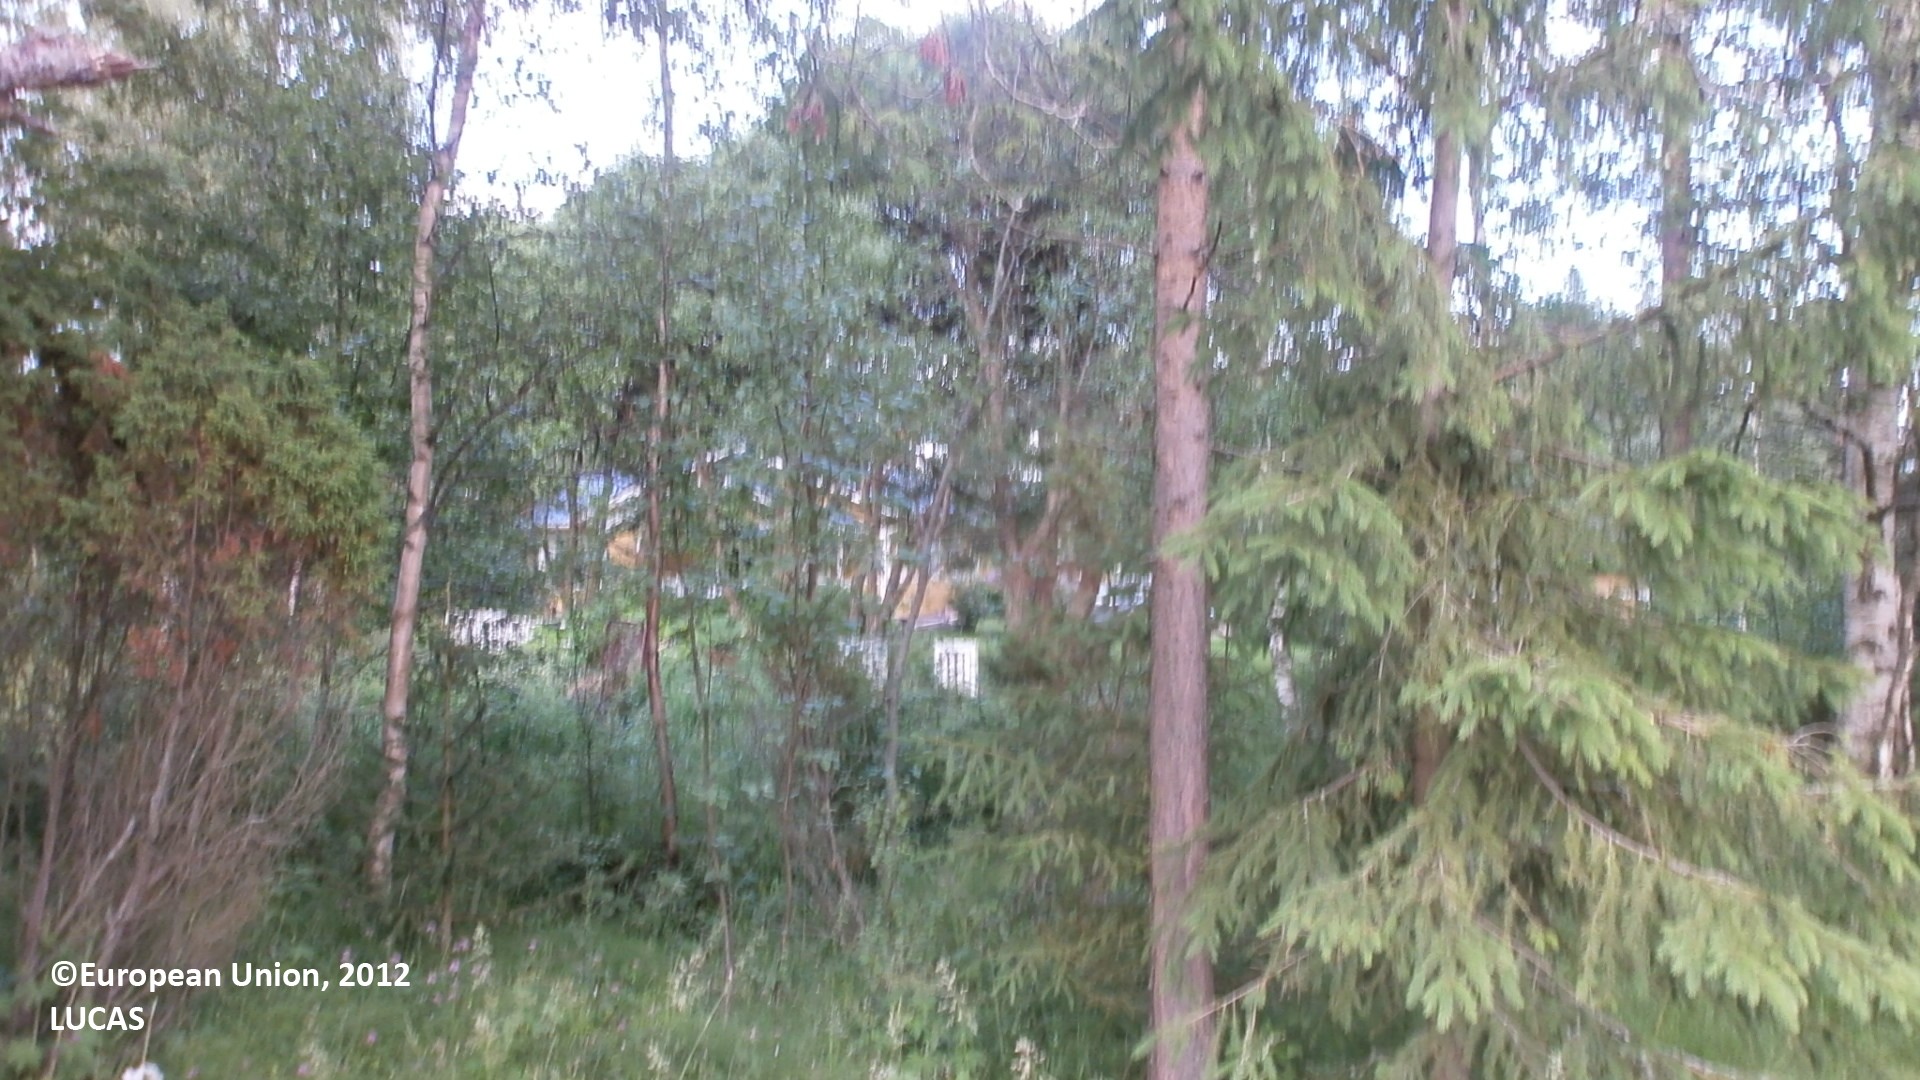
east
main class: Woodland
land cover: Spruce dominated mixed woodland
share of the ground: 50 - 75 %
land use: Residential
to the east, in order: Shruby margins; Spruce dominated mixed woodland; Ditches and canals; Abandoned hedges; Grassland without tree/shrub cover; Ditches and canals; Fences; Lines of trees; Artificial constructions in urban areas; Ditches and canals; Pine dominated mixed woodland; Grassland with sparse tree/shrub cover; Broadleaved woodland; Pine dominated coniferous woodland; Tracks; Pine dominated coniferous woodland; Grassland without tree/shrub cover; Other structural elements; Grassland without tree/shrub cover
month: July
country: FI
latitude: 64.7305
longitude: 24.6186
